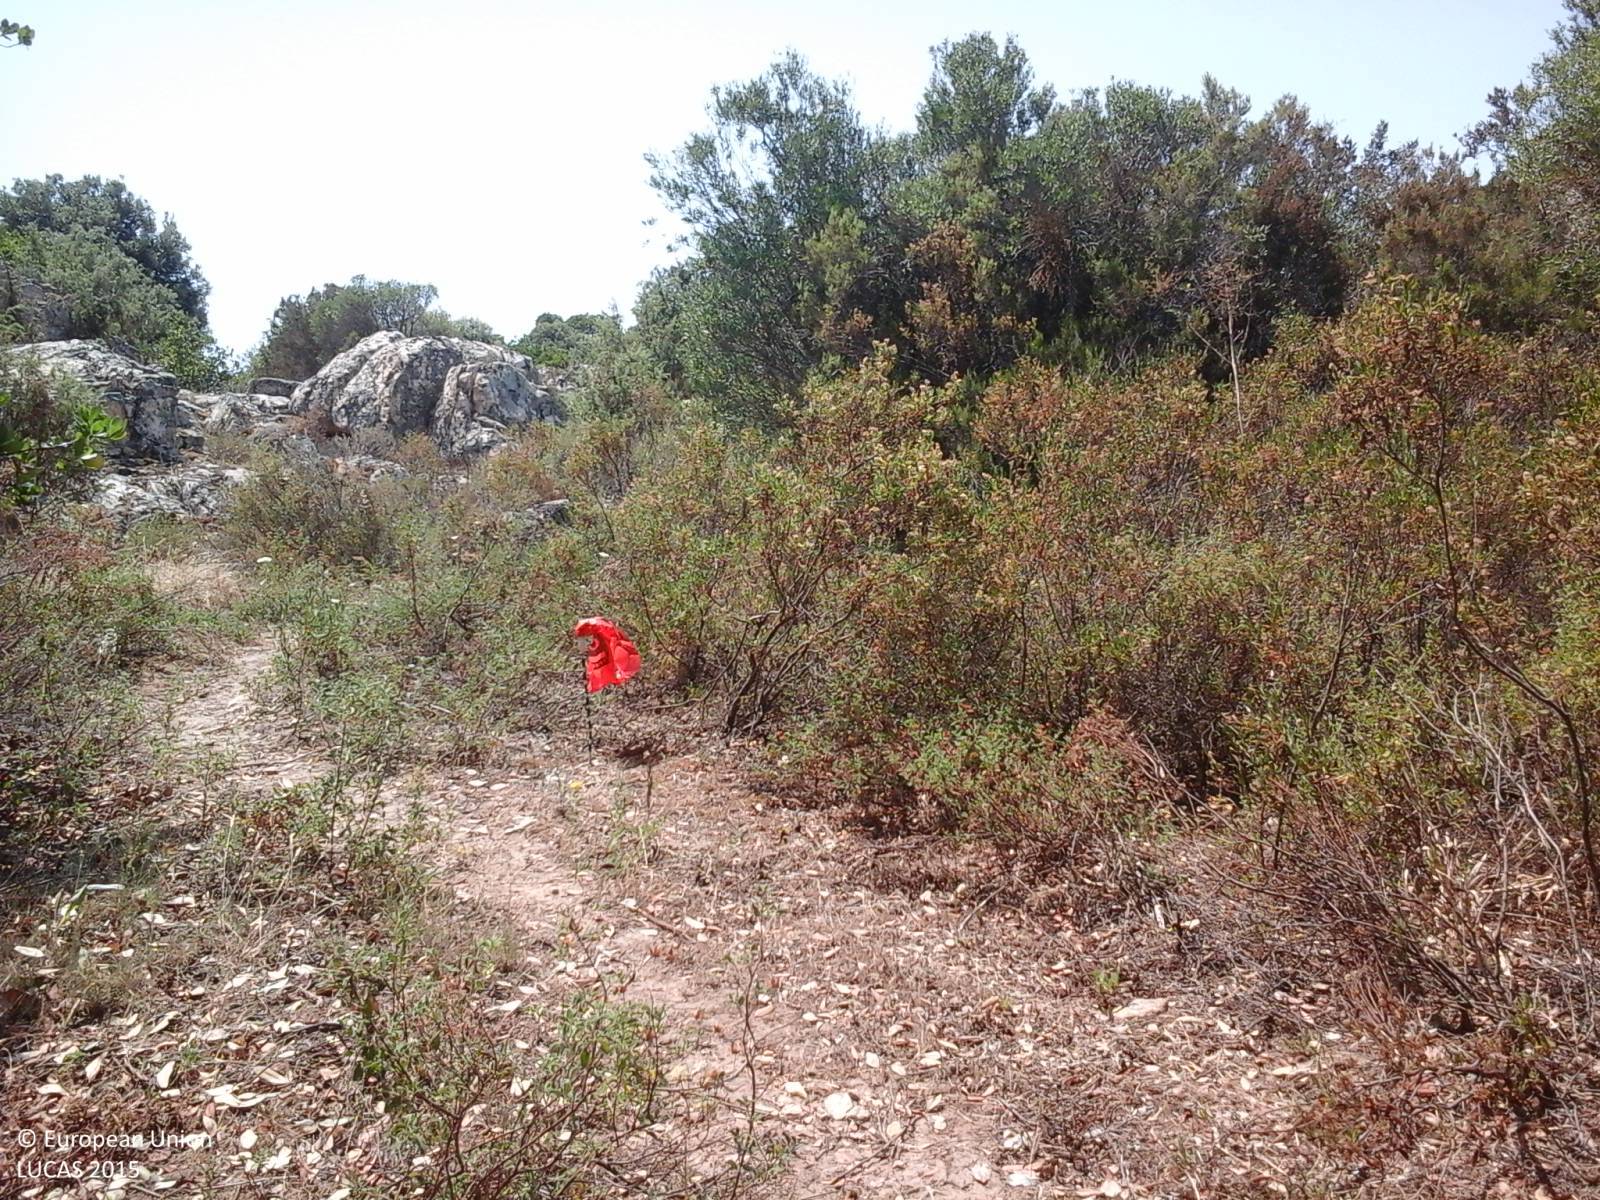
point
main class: Shrubland
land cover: Shrubland with sparse tree cover
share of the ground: > 75 %
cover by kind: shrubs 90 %, broadleaved forest trees 5 %, unconsolidated bare surface 5 %
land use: Agriculture (excluding fallow land and kitchen gardens)
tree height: > 5 m
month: July
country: IT
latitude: 40.6824
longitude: 9.5173
